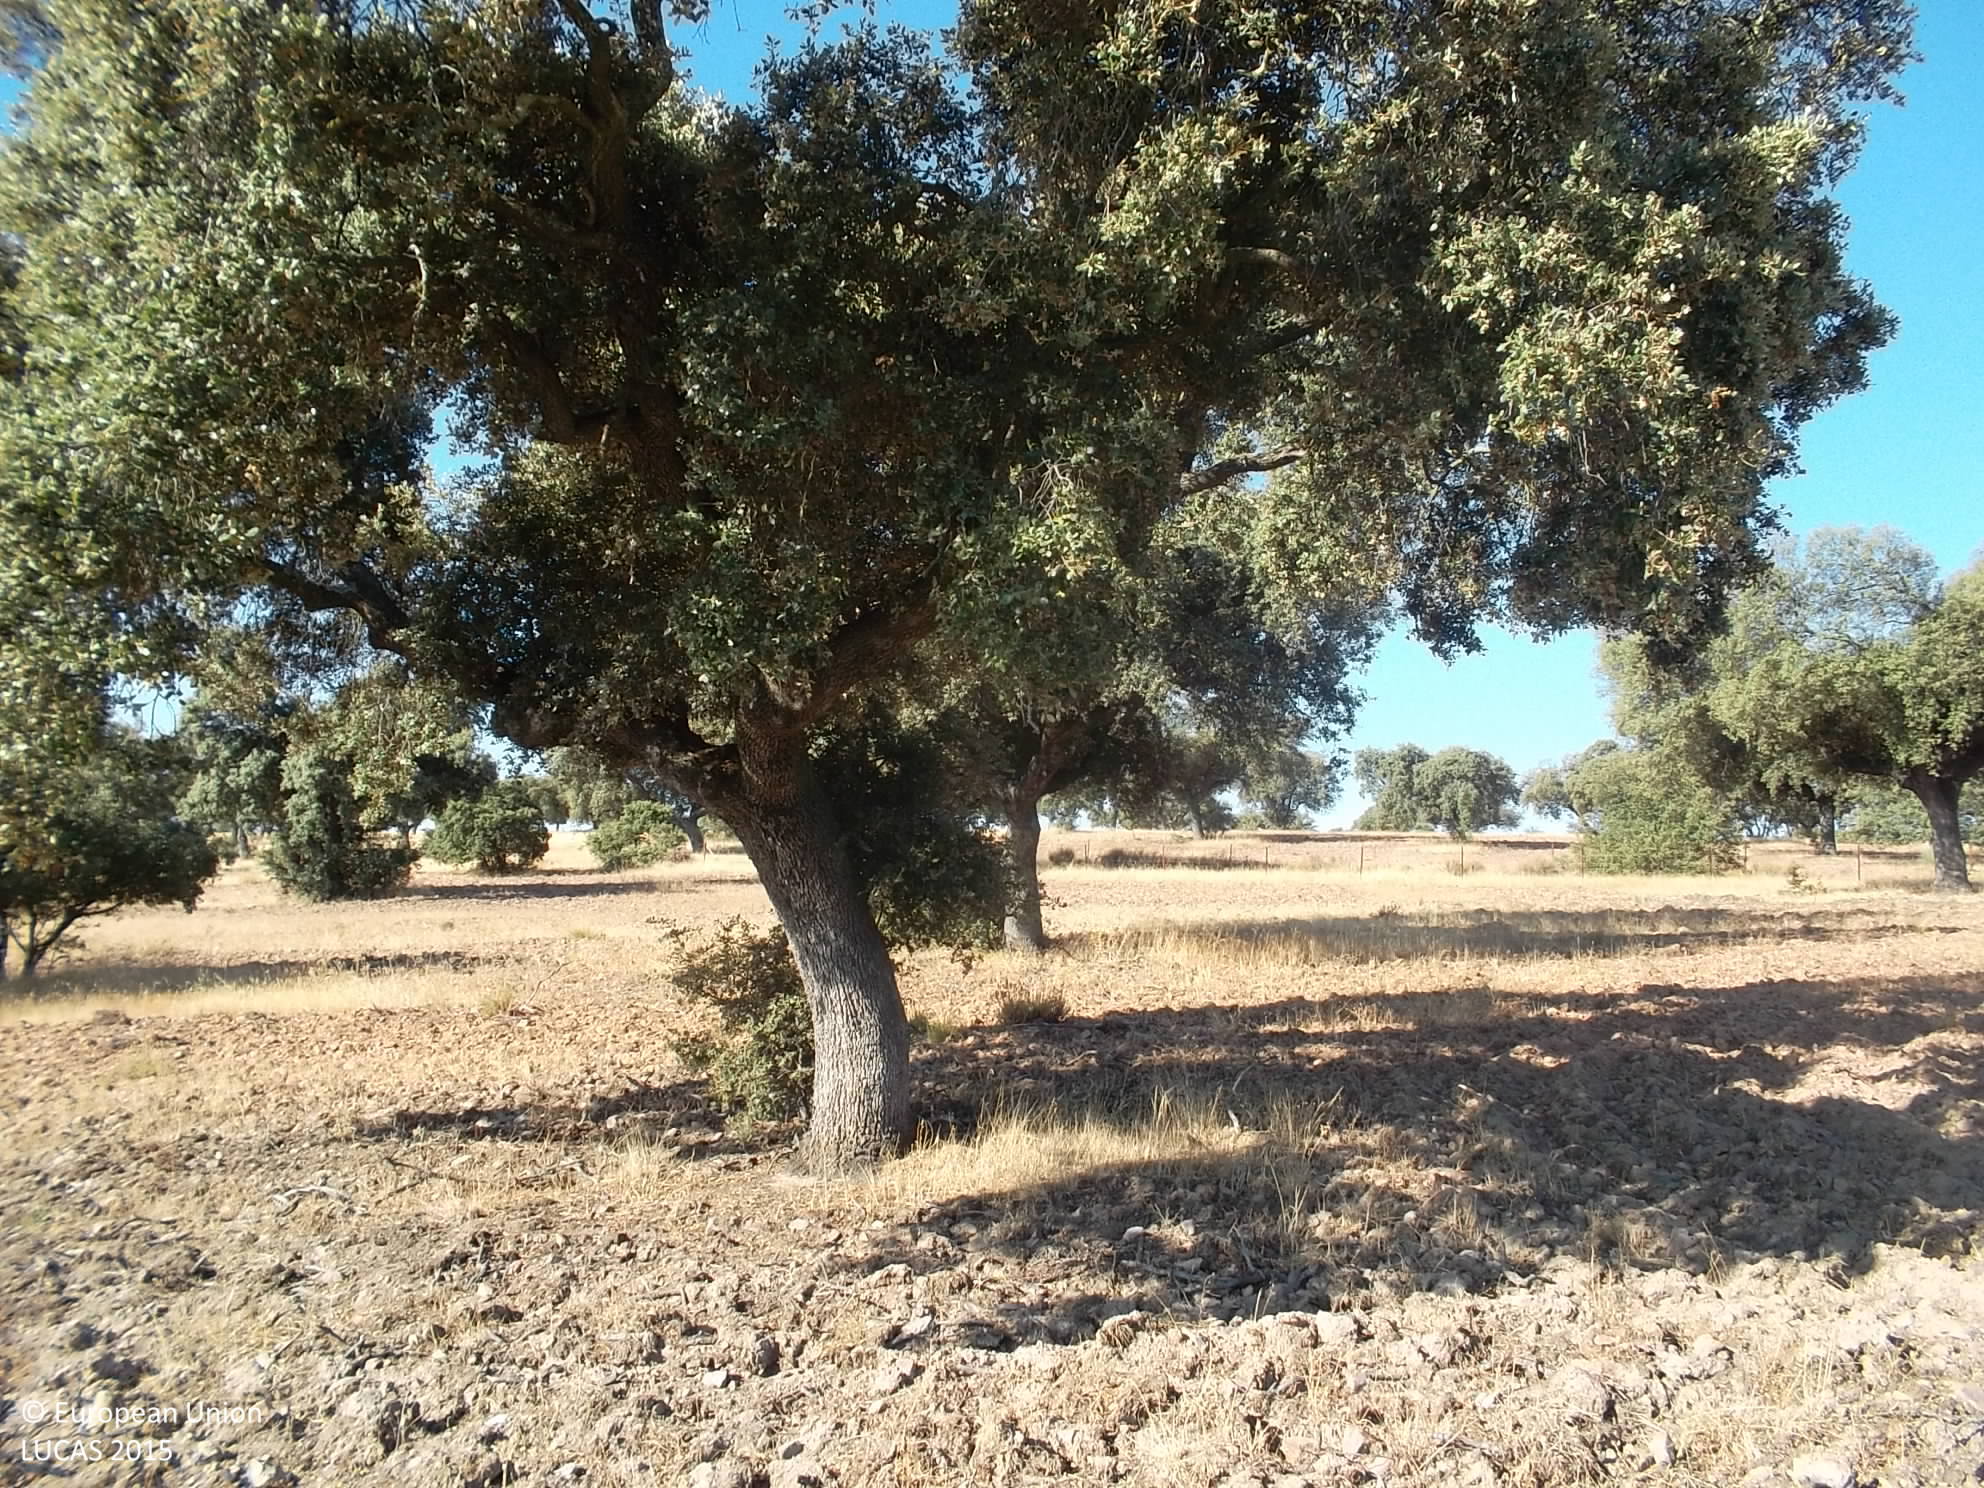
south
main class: Woodland
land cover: Broadleaved woodland
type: broadleaved evergreen forest
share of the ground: 10 - 25 %
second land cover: Grassland without tree/shrub cover
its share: 10 - 25 %
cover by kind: herbaceous plants 80 %, broadleaved forest trees 20 %
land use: Forestry
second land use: Agriculture (excluding fallow land and kitchen gardens)
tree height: > 5 m
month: July
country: ES
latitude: 38.4909
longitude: -5.8513
